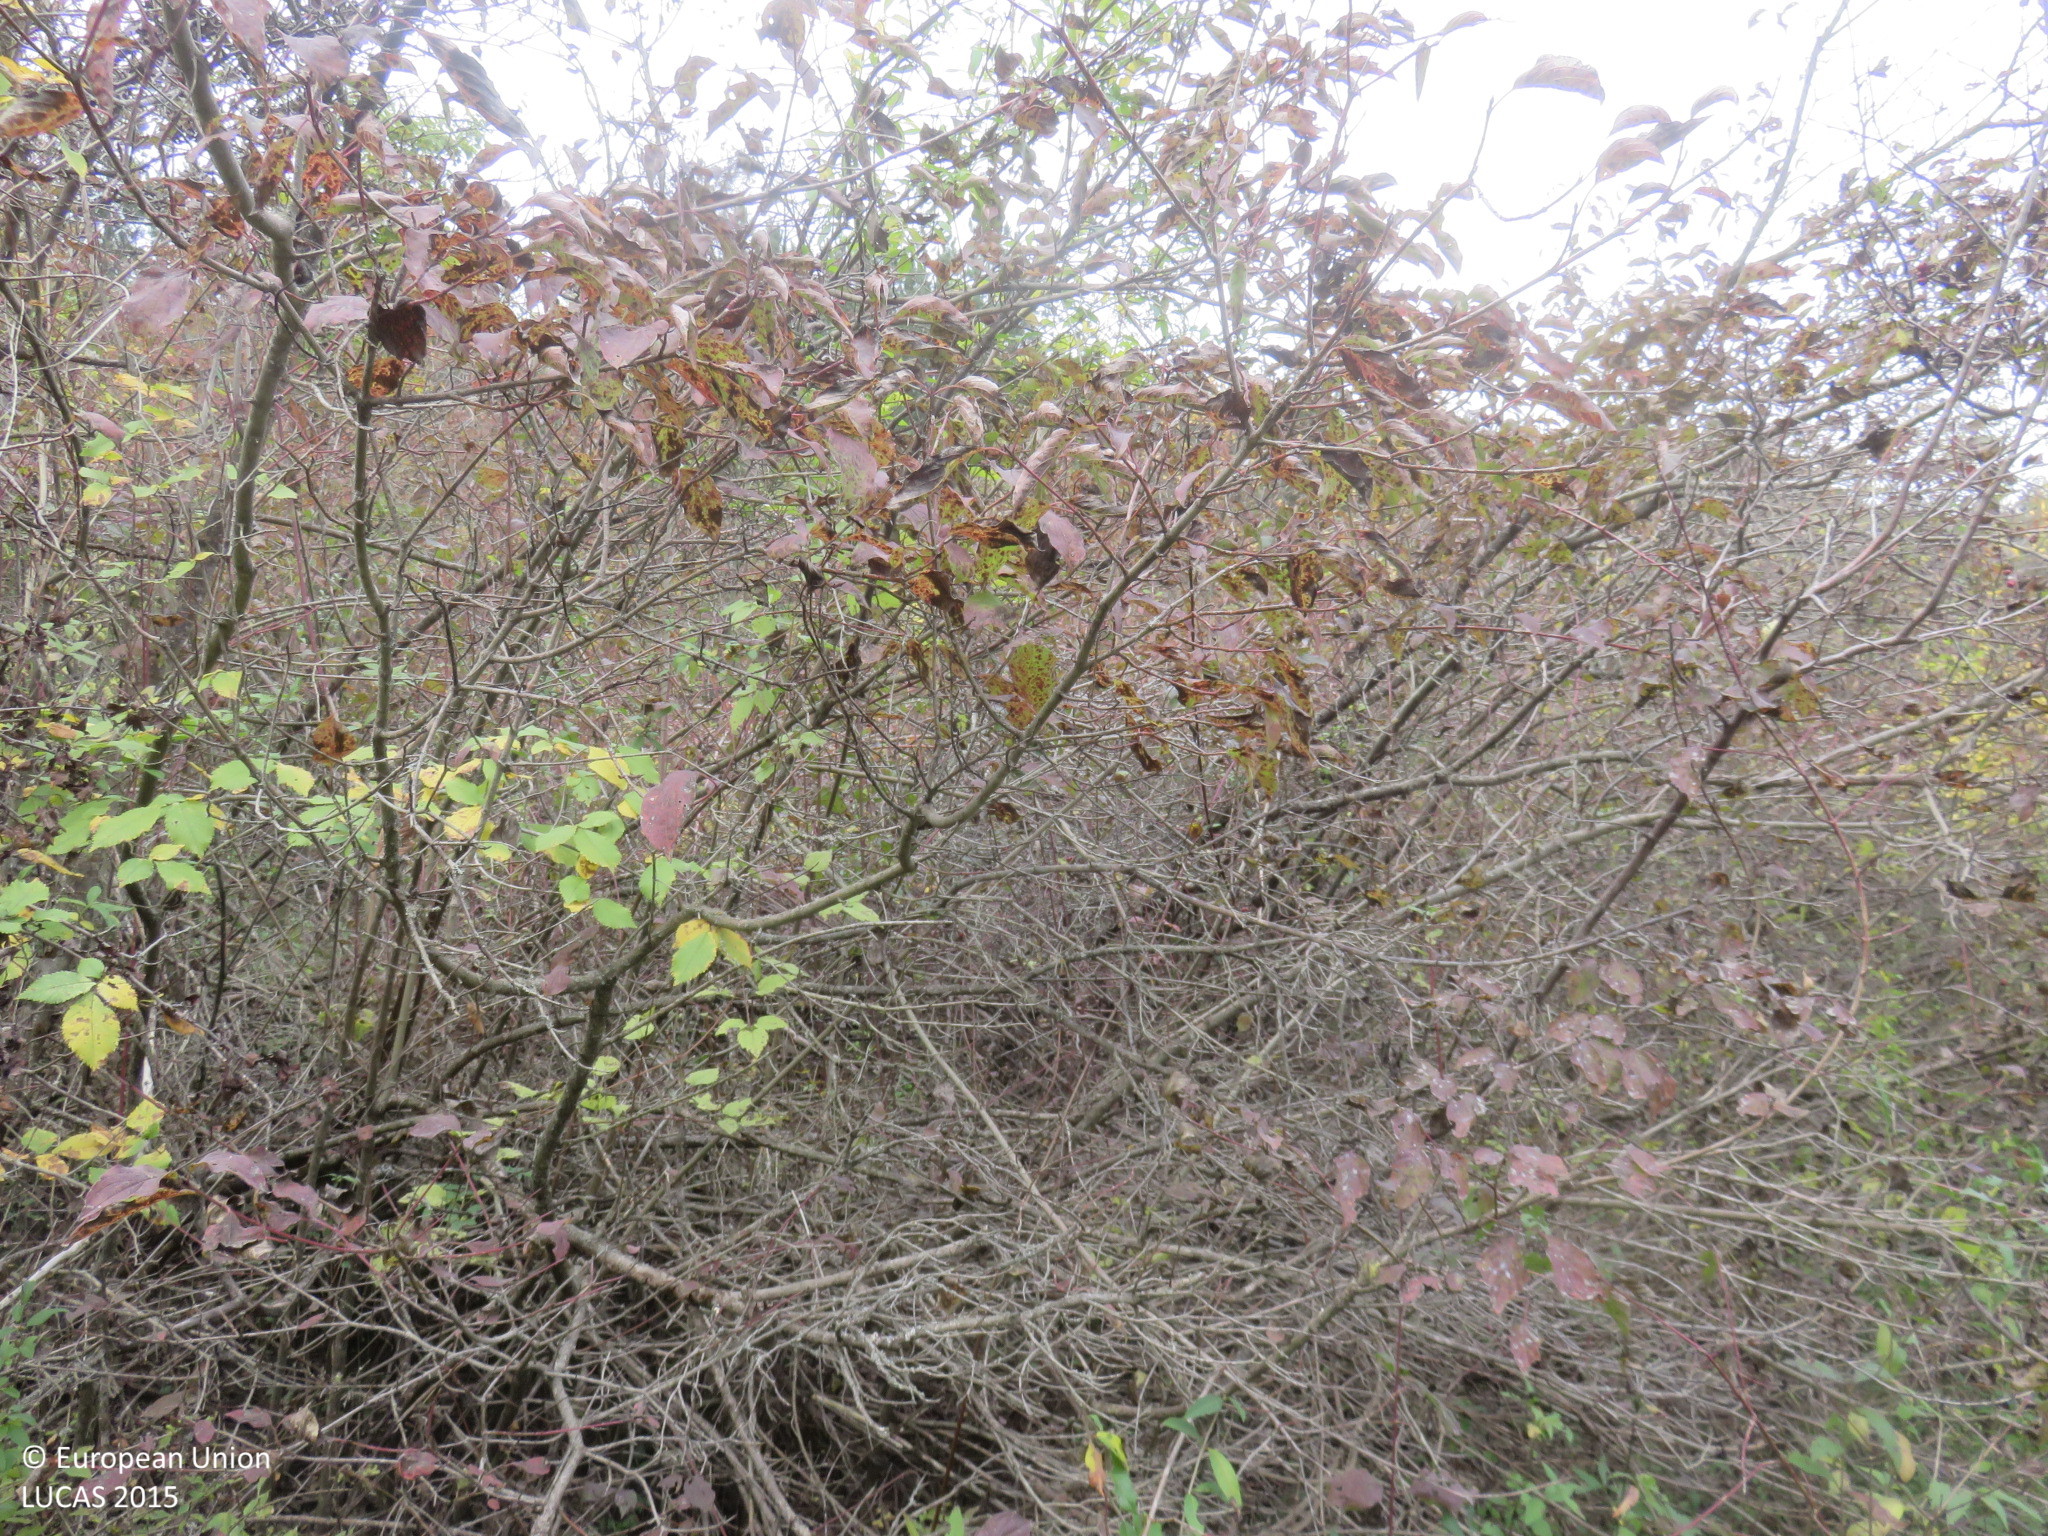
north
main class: Shrubland
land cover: Shrubland with sparse tree cover
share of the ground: > 75 %
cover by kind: shrubs 85 %, herbaceous plants 10 %, broadleaved forest trees 5 %
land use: Semi-natural and natural areas not in use
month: October
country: BG
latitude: 42.9973
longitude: 24.9936
